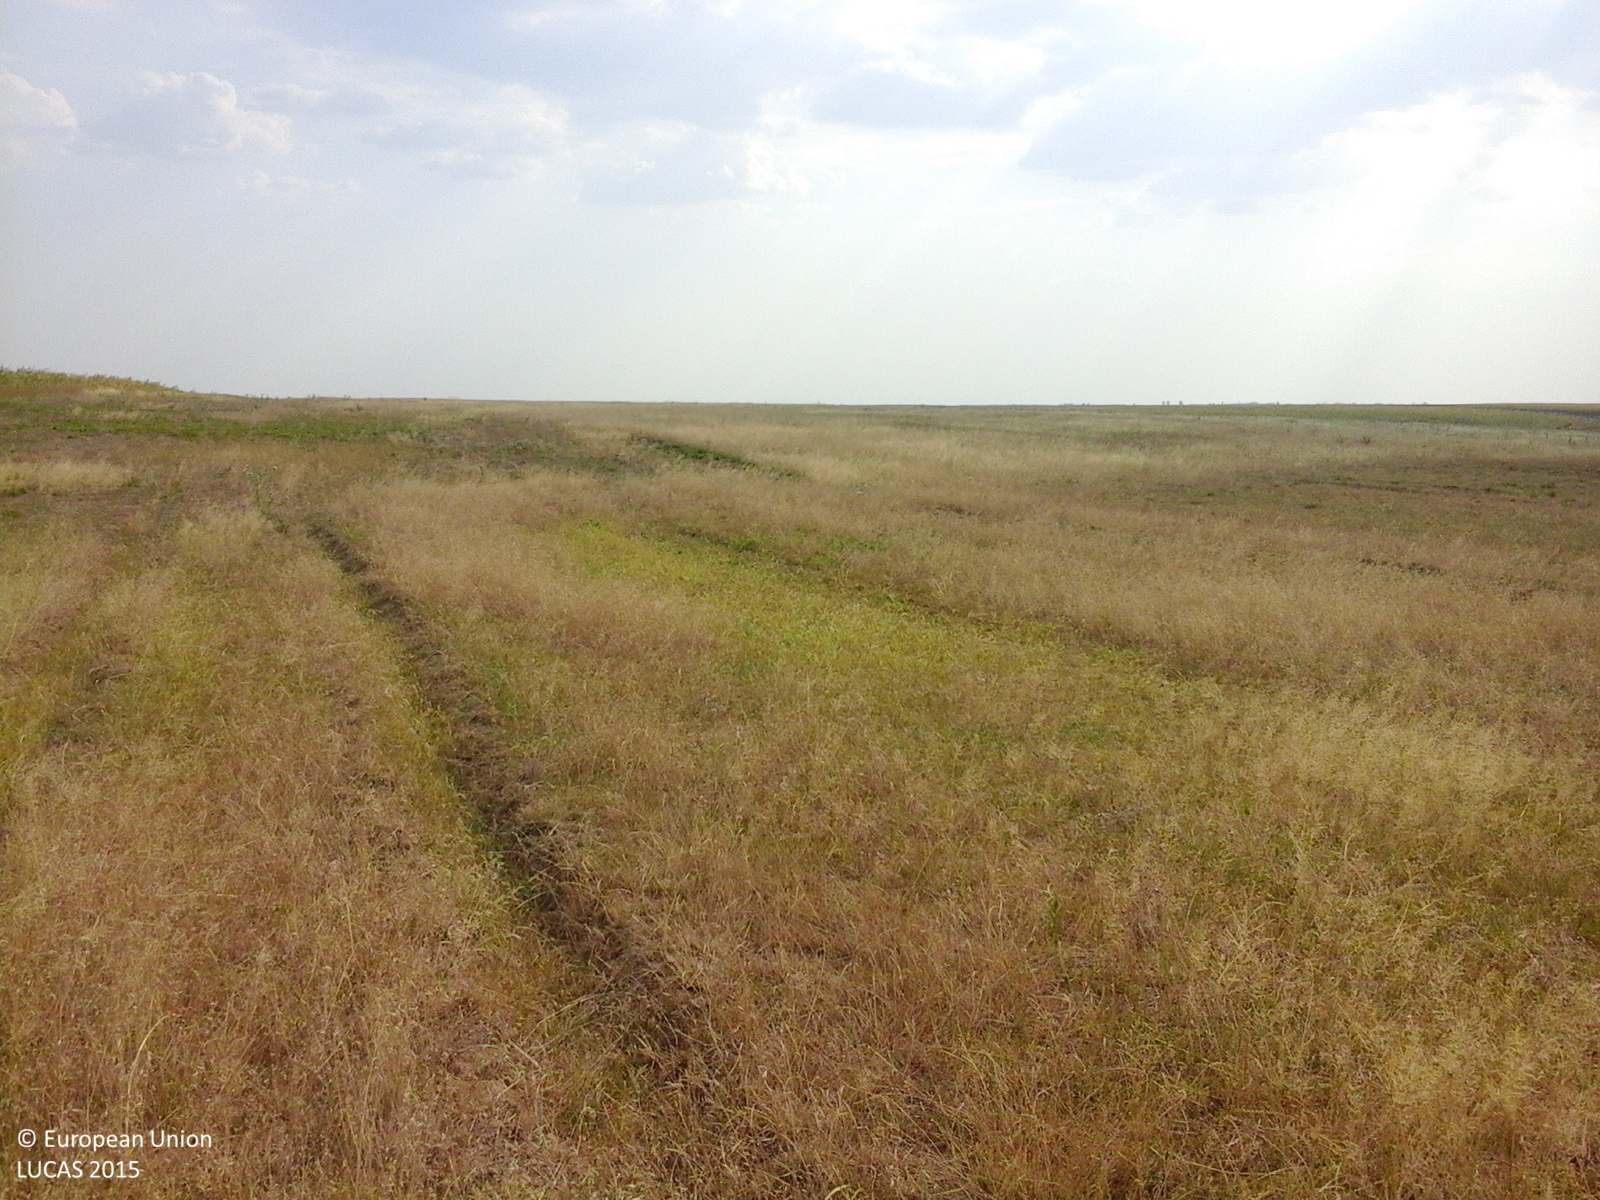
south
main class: Grassland
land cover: Grassland without tree/shrub cover
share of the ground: > 75 %
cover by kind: herbaceous plants 100 %
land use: Agriculture (excluding fallow land and kitchen gardens)
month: August
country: RO
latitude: 44.3131
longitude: 23.1474
